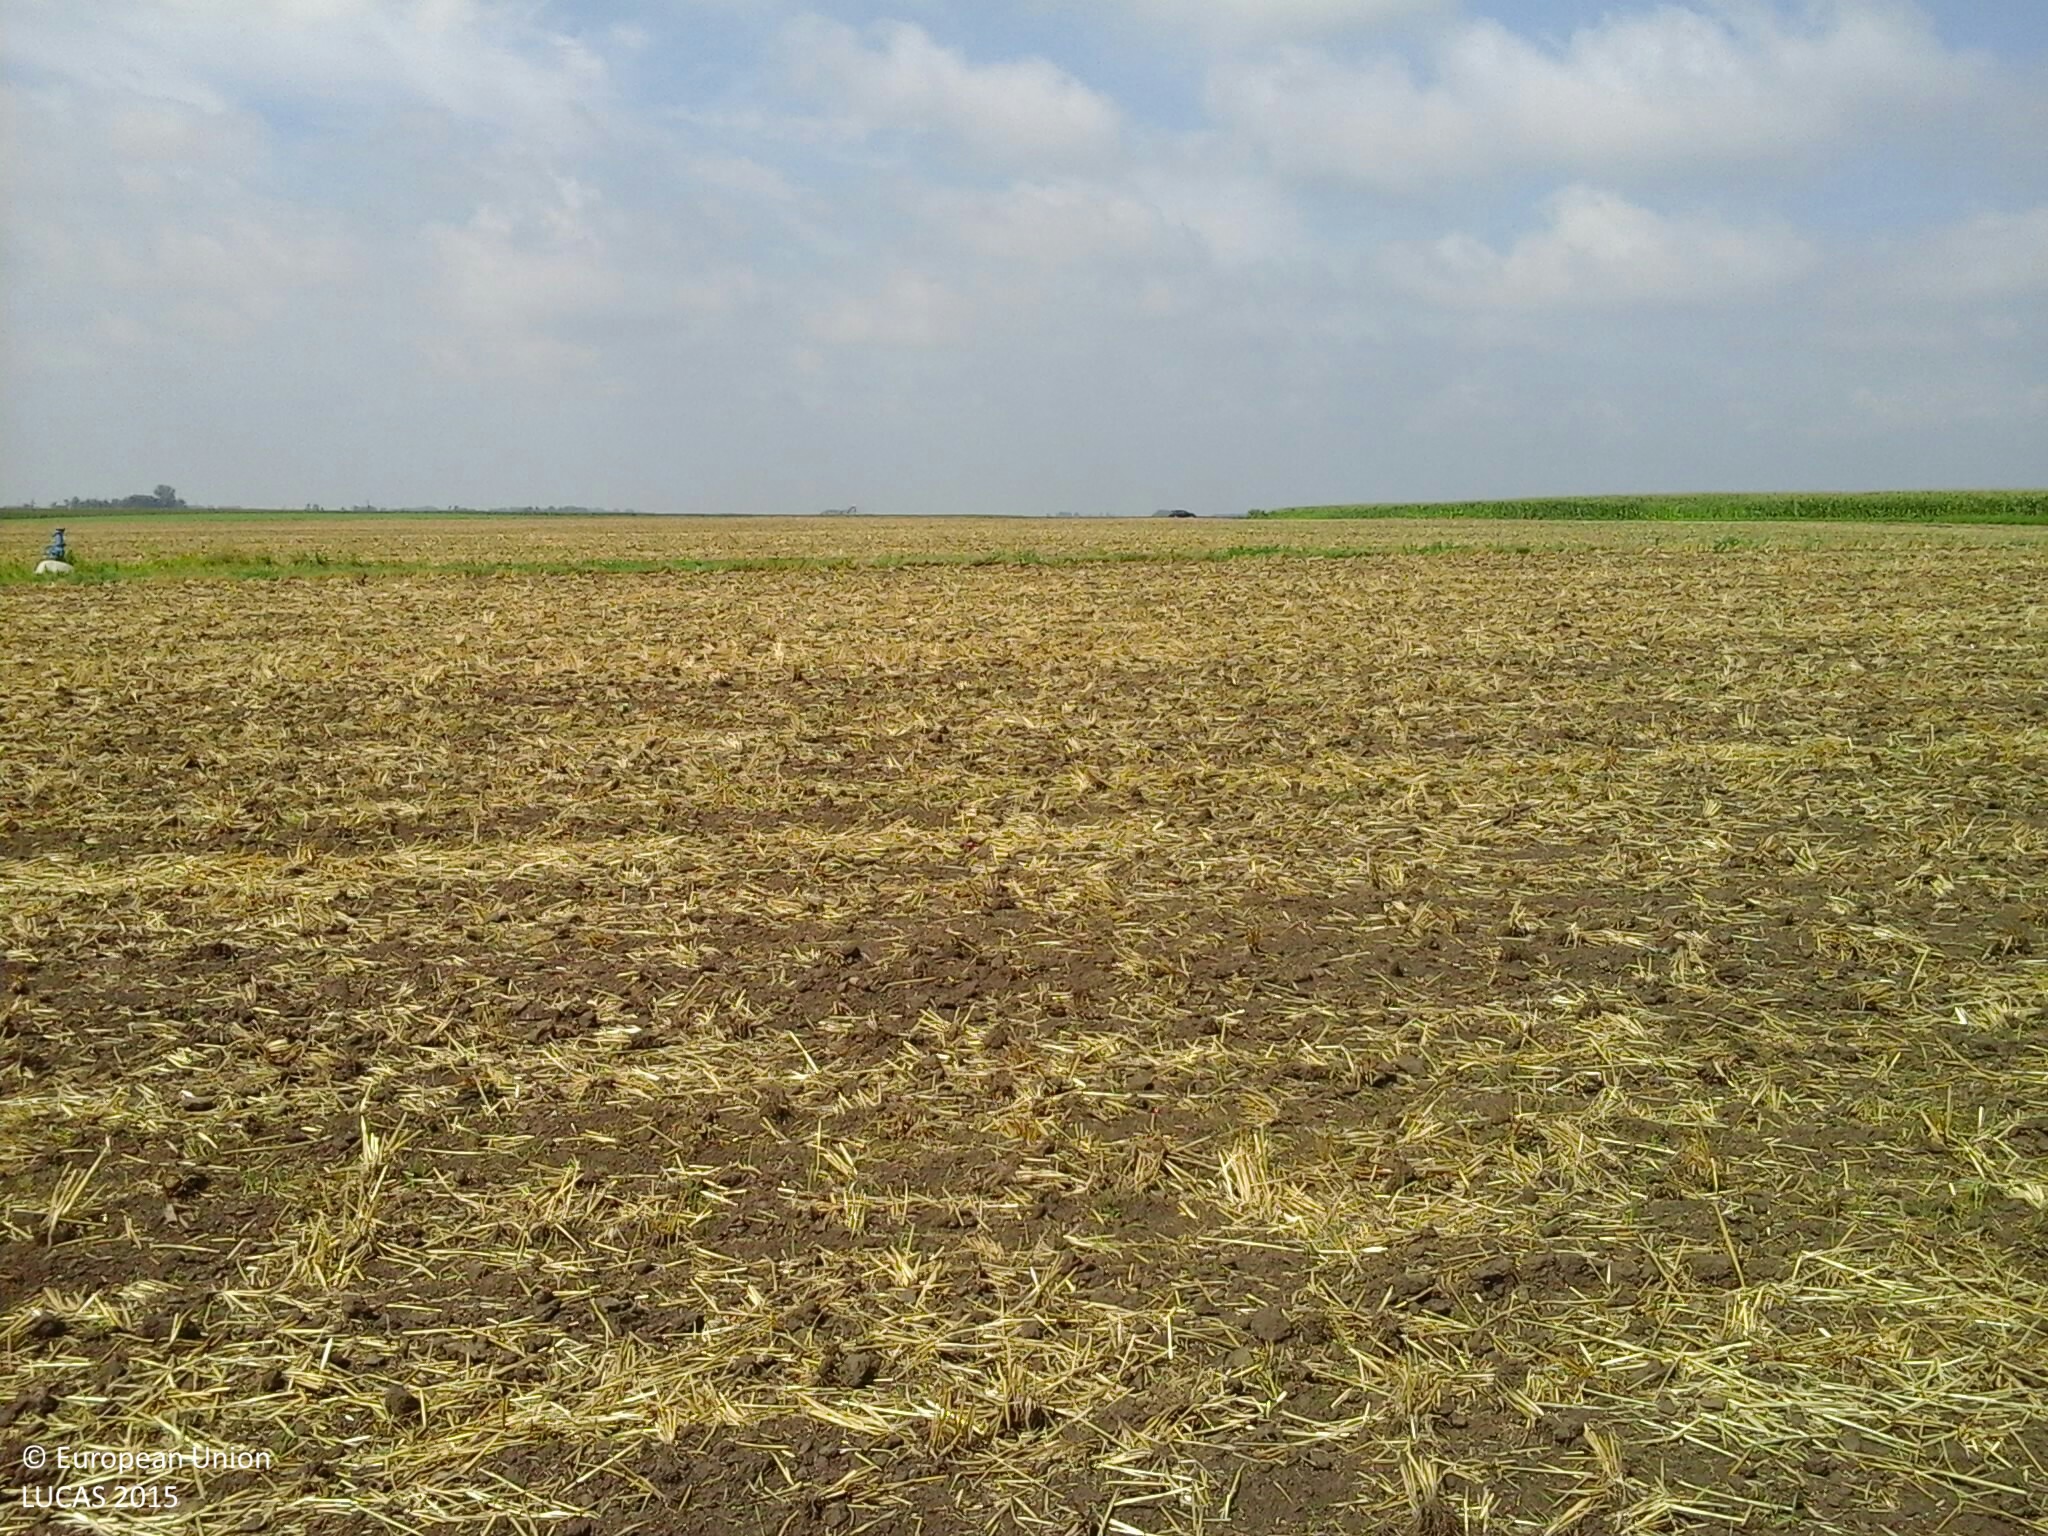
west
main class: Cropland
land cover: Common wheat
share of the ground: 10 - 25 %
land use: Agriculture (excluding fallow land and kitchen gardens)
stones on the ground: < 10 %
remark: Harvested field
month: July
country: HU
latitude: 47.9119
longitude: 21.4843
